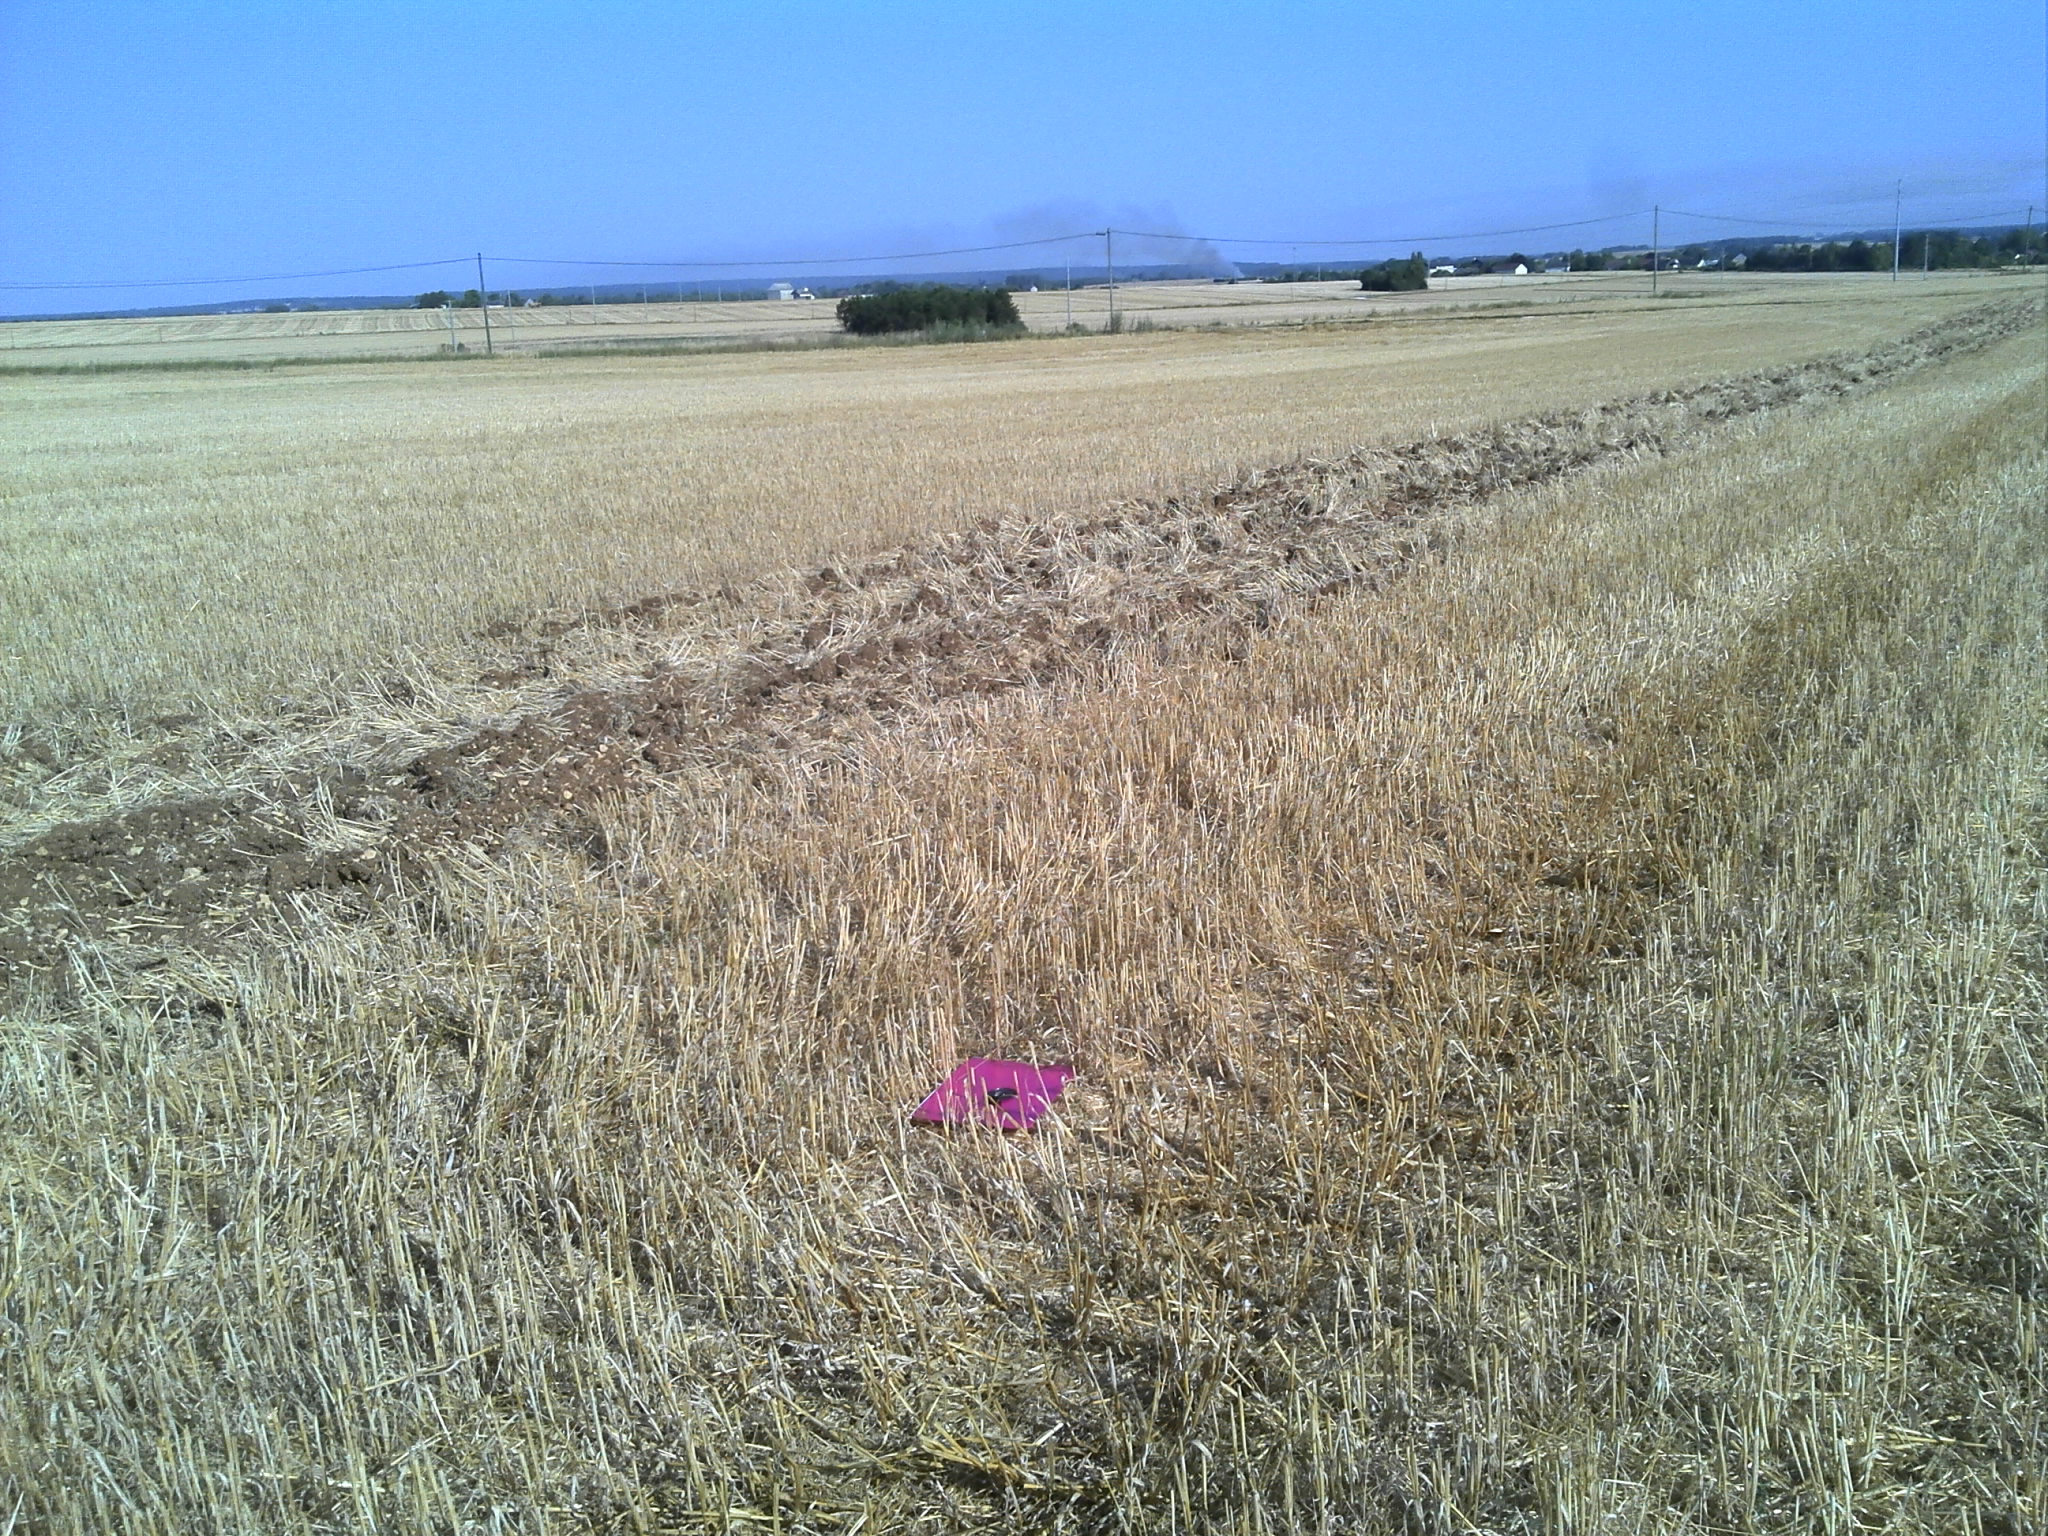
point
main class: Cropland
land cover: Barley
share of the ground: > 75 %
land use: Agriculture (excluding fallow land and kitchen gardens)
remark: Harvested field
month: July
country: FR
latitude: 46.9630
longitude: 1.6172
